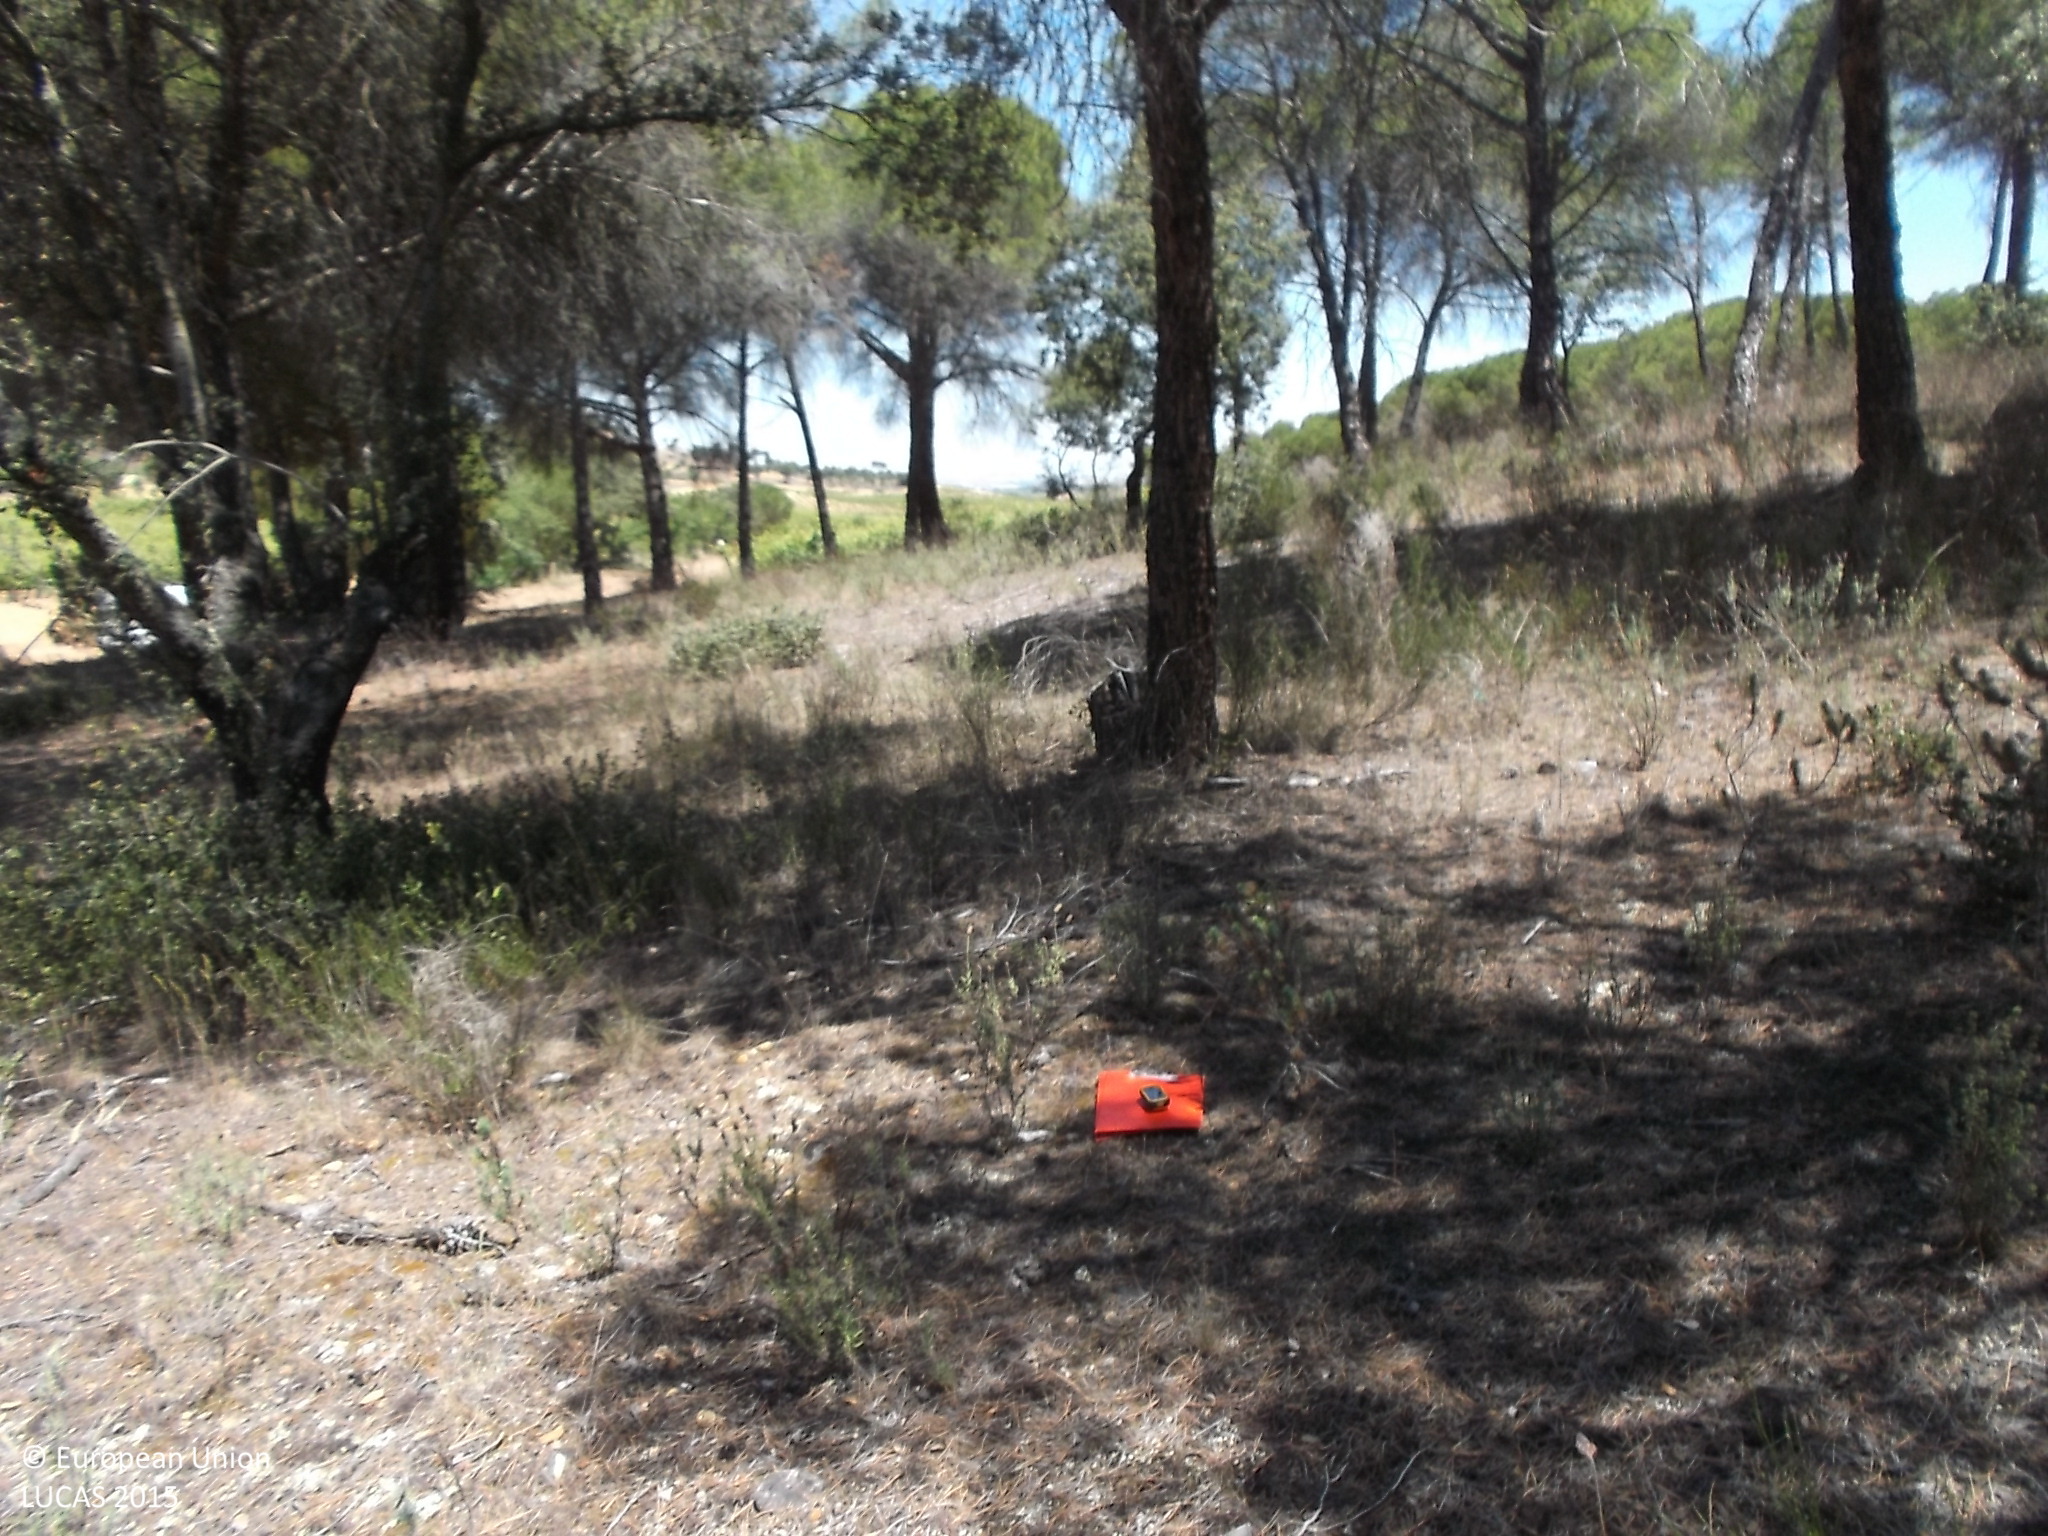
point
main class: Woodland
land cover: Pine dominated mixed woodland
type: coniferous forest of the mediterranean region
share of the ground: > 75 %
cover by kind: coniferous forest trees 50 %, broadleaved forest trees 25 %, herbaceous plants 25 %
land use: Forestry
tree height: > 5 m
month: June
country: ES
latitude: 41.4368
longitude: -5.4829
